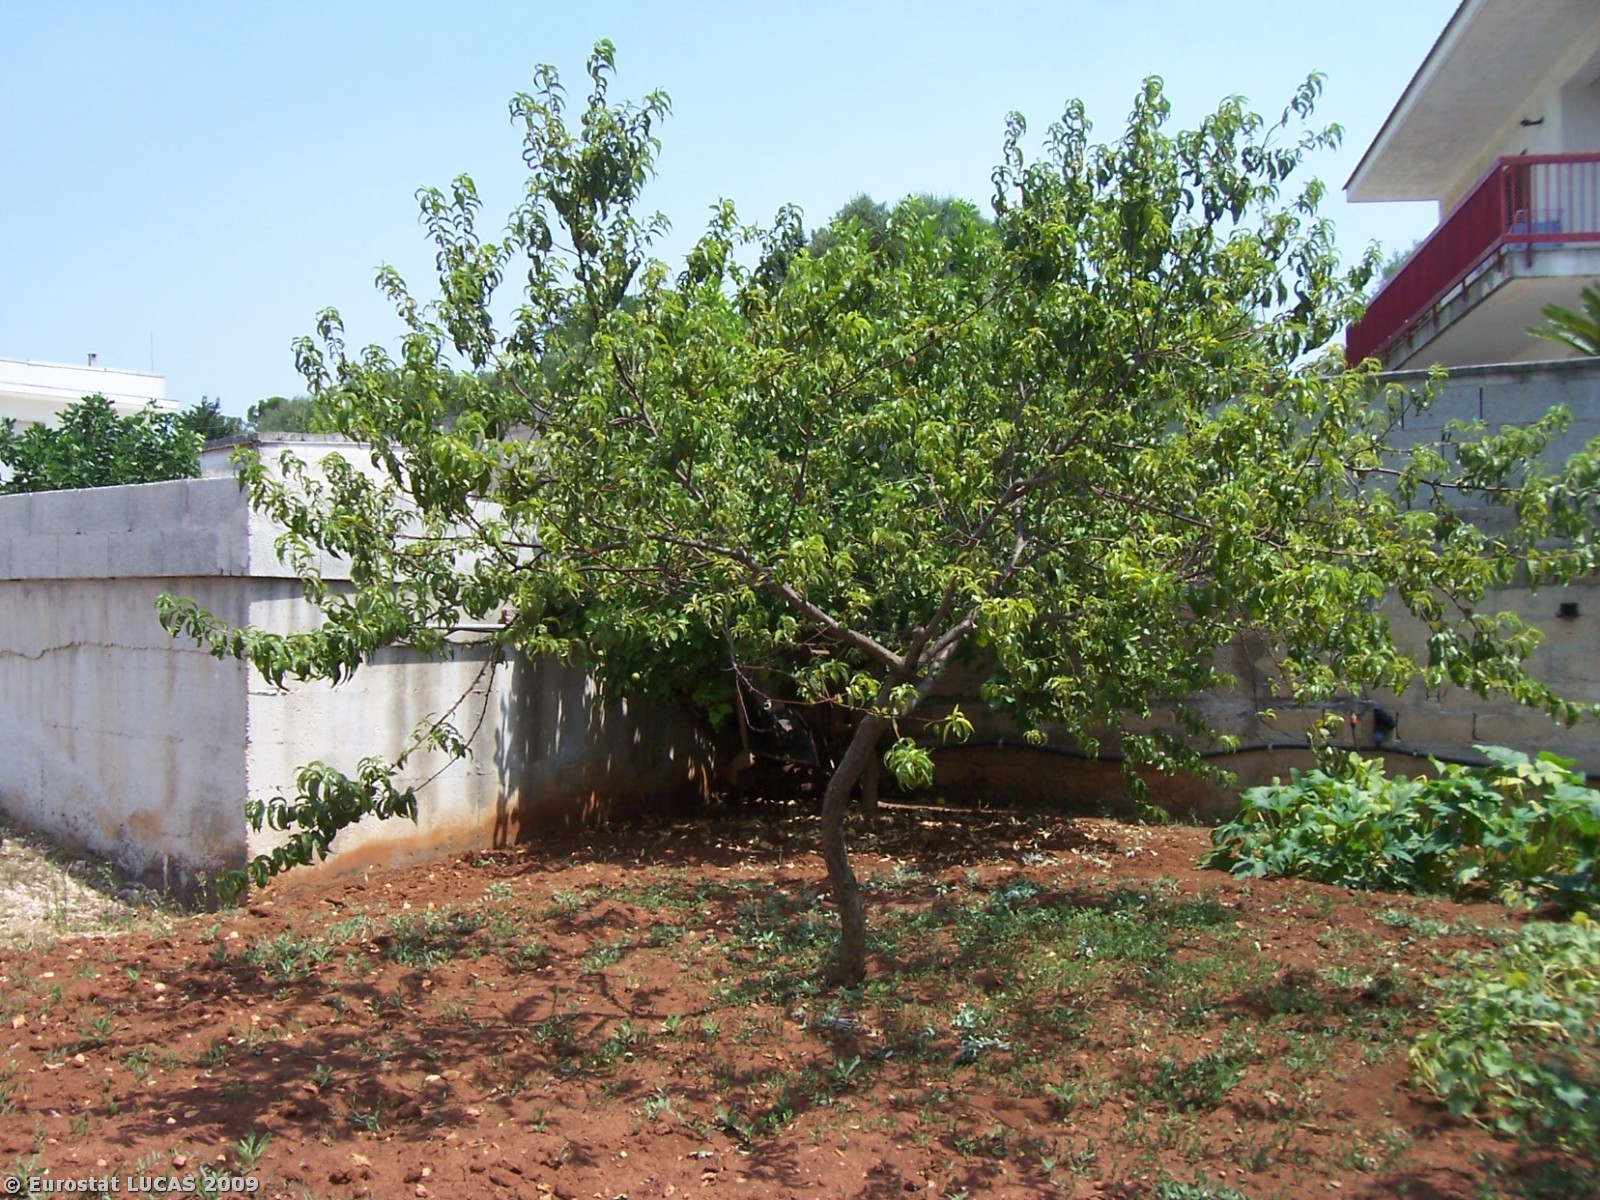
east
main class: Cropland
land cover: Cherry fruit
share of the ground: 50 - 75 %
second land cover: Other fruit trees and berries
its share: > 75 %
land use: Kitchen garden
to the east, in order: Cherry fruit; Bare land; Other fruit trees and berries; Bare land; Artificial constructions in urban areas; Olive groves; Bare land; Grassland with sparse tree/shrub cover; Dry stone walls; Shrubland with sparse tree cover
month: July
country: IT
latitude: 40.7196
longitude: 17.5657
